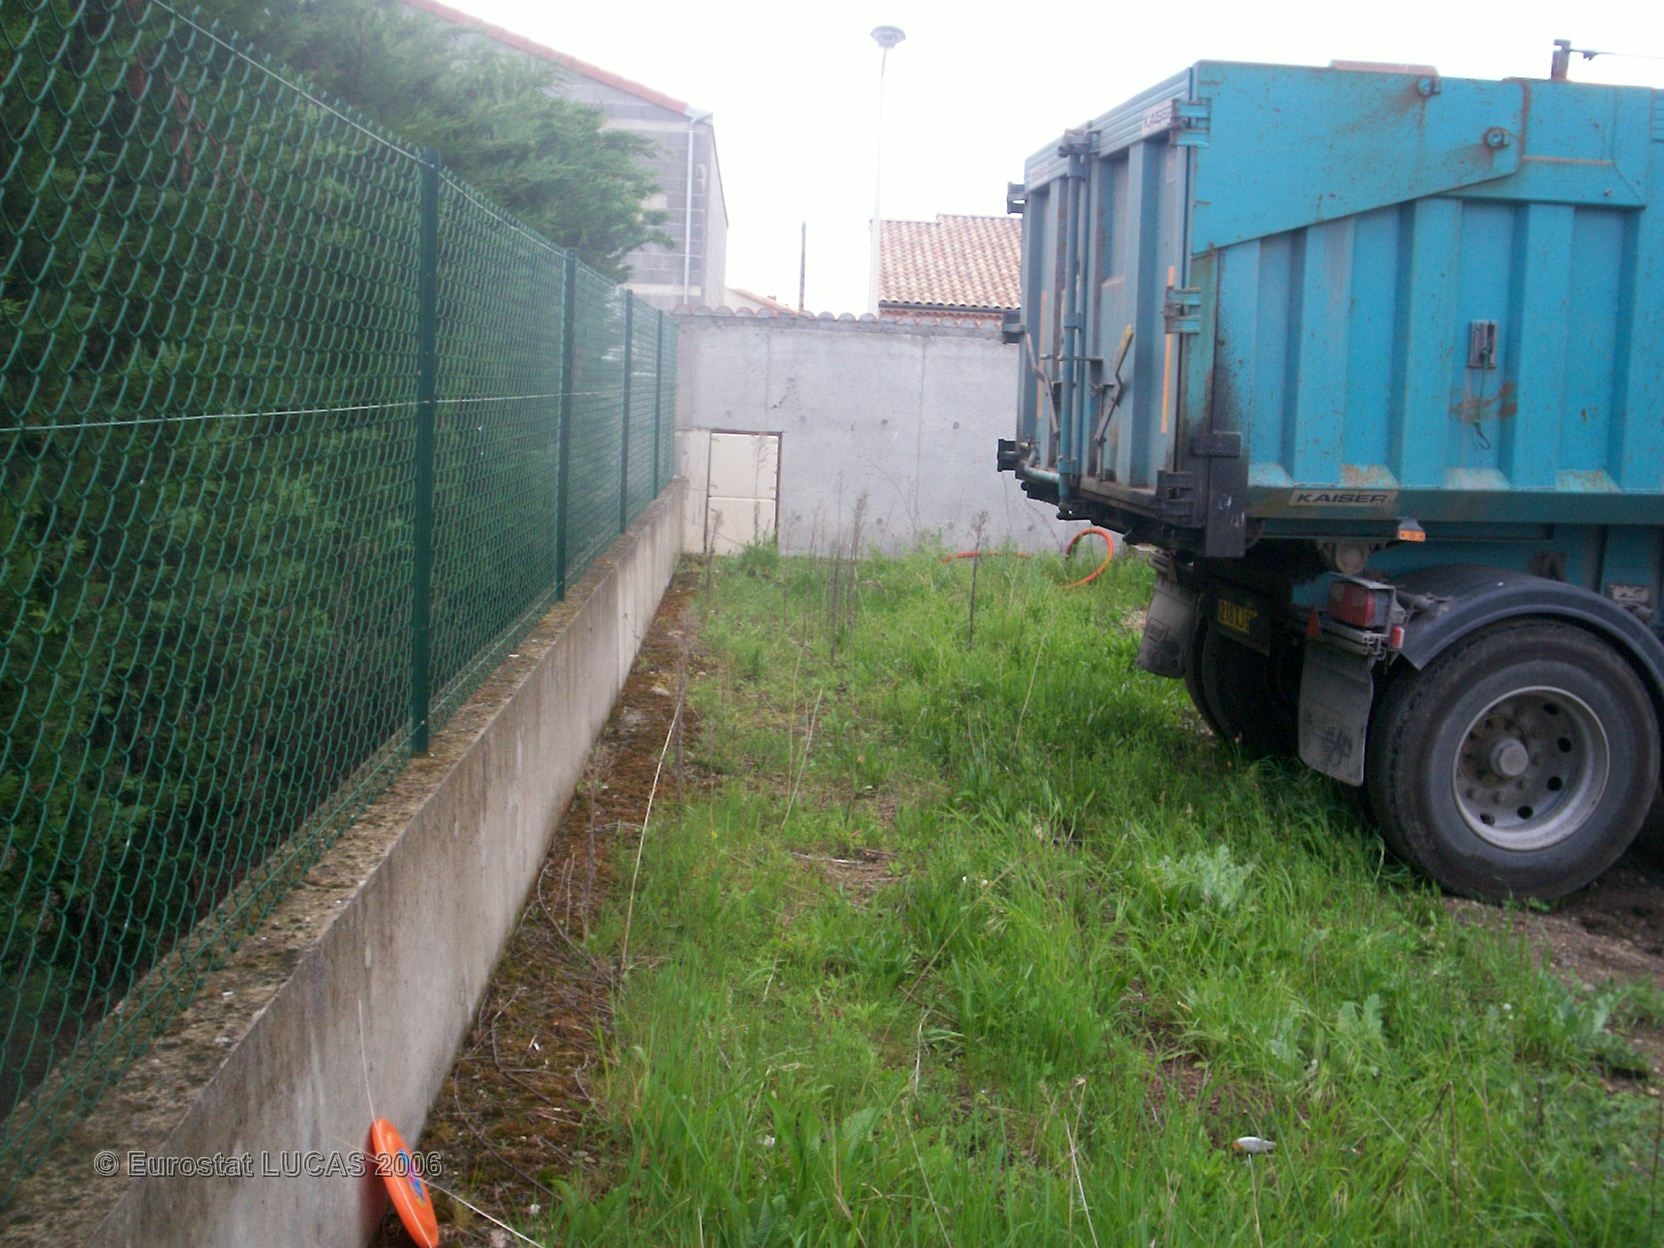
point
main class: Grassland
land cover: Grassland without tree/shrub cover
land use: Residential
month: May
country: FR
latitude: 45.8317
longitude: 3.2673
